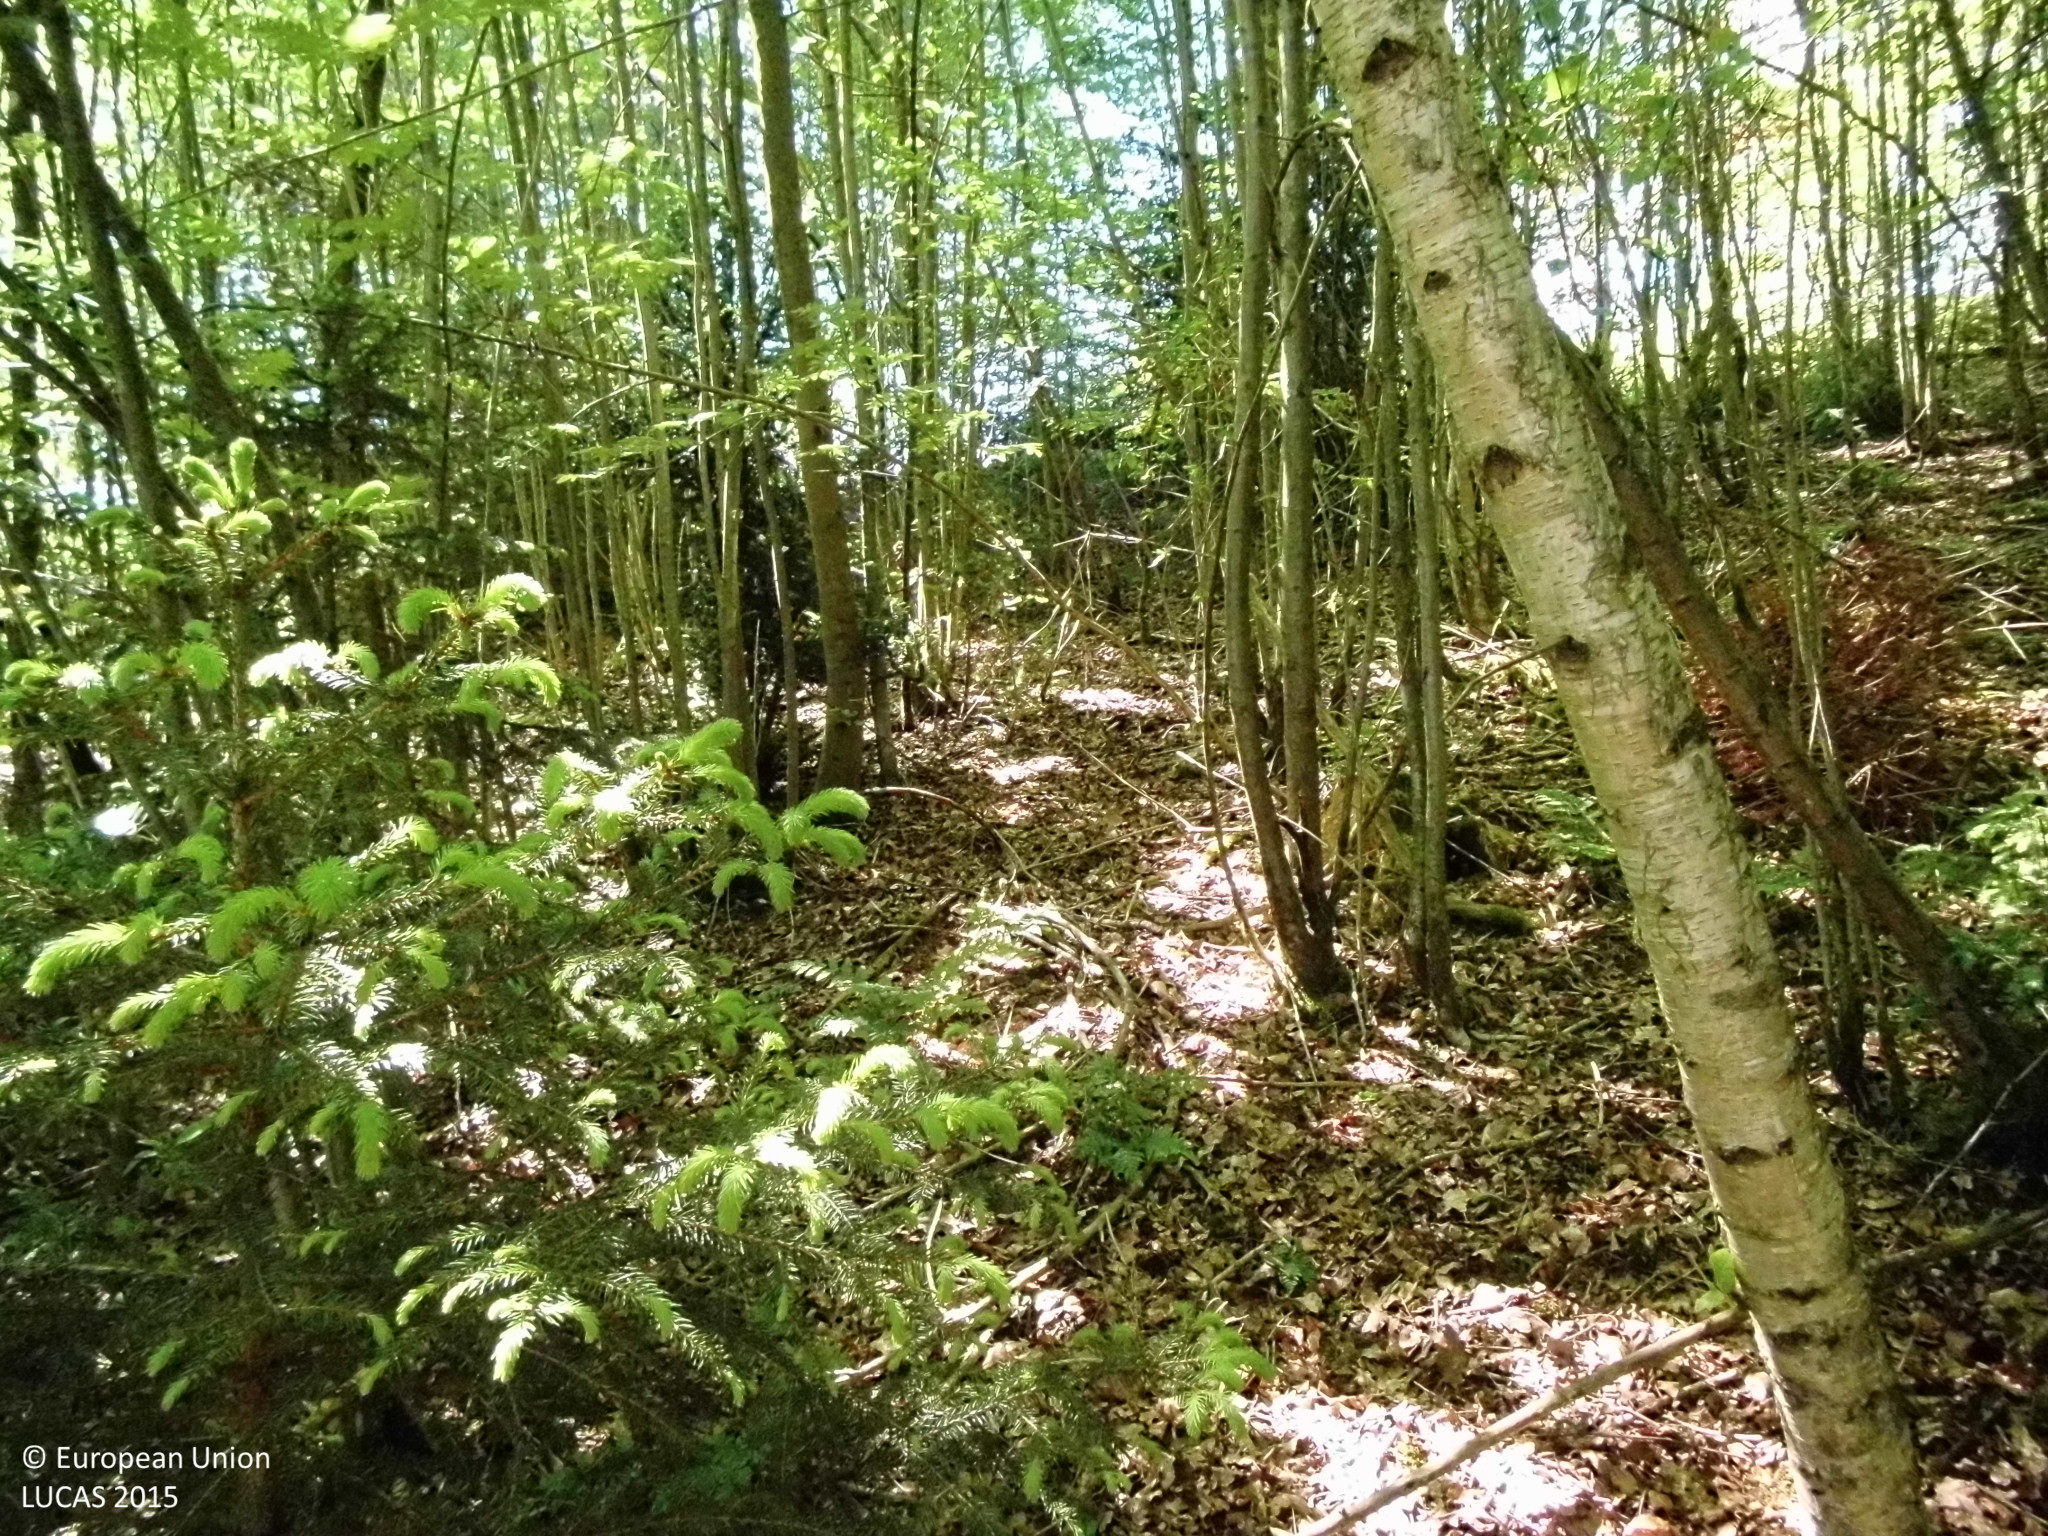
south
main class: Woodland
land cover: Broadleaved woodland
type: mesophytic deciduous forest
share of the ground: > 75 %
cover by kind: broadleaved forest trees 85 %, coniferous forest trees 15 %
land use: Forestry
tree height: > 5 m
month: June
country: DE
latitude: 50.9220
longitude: 7.9945
